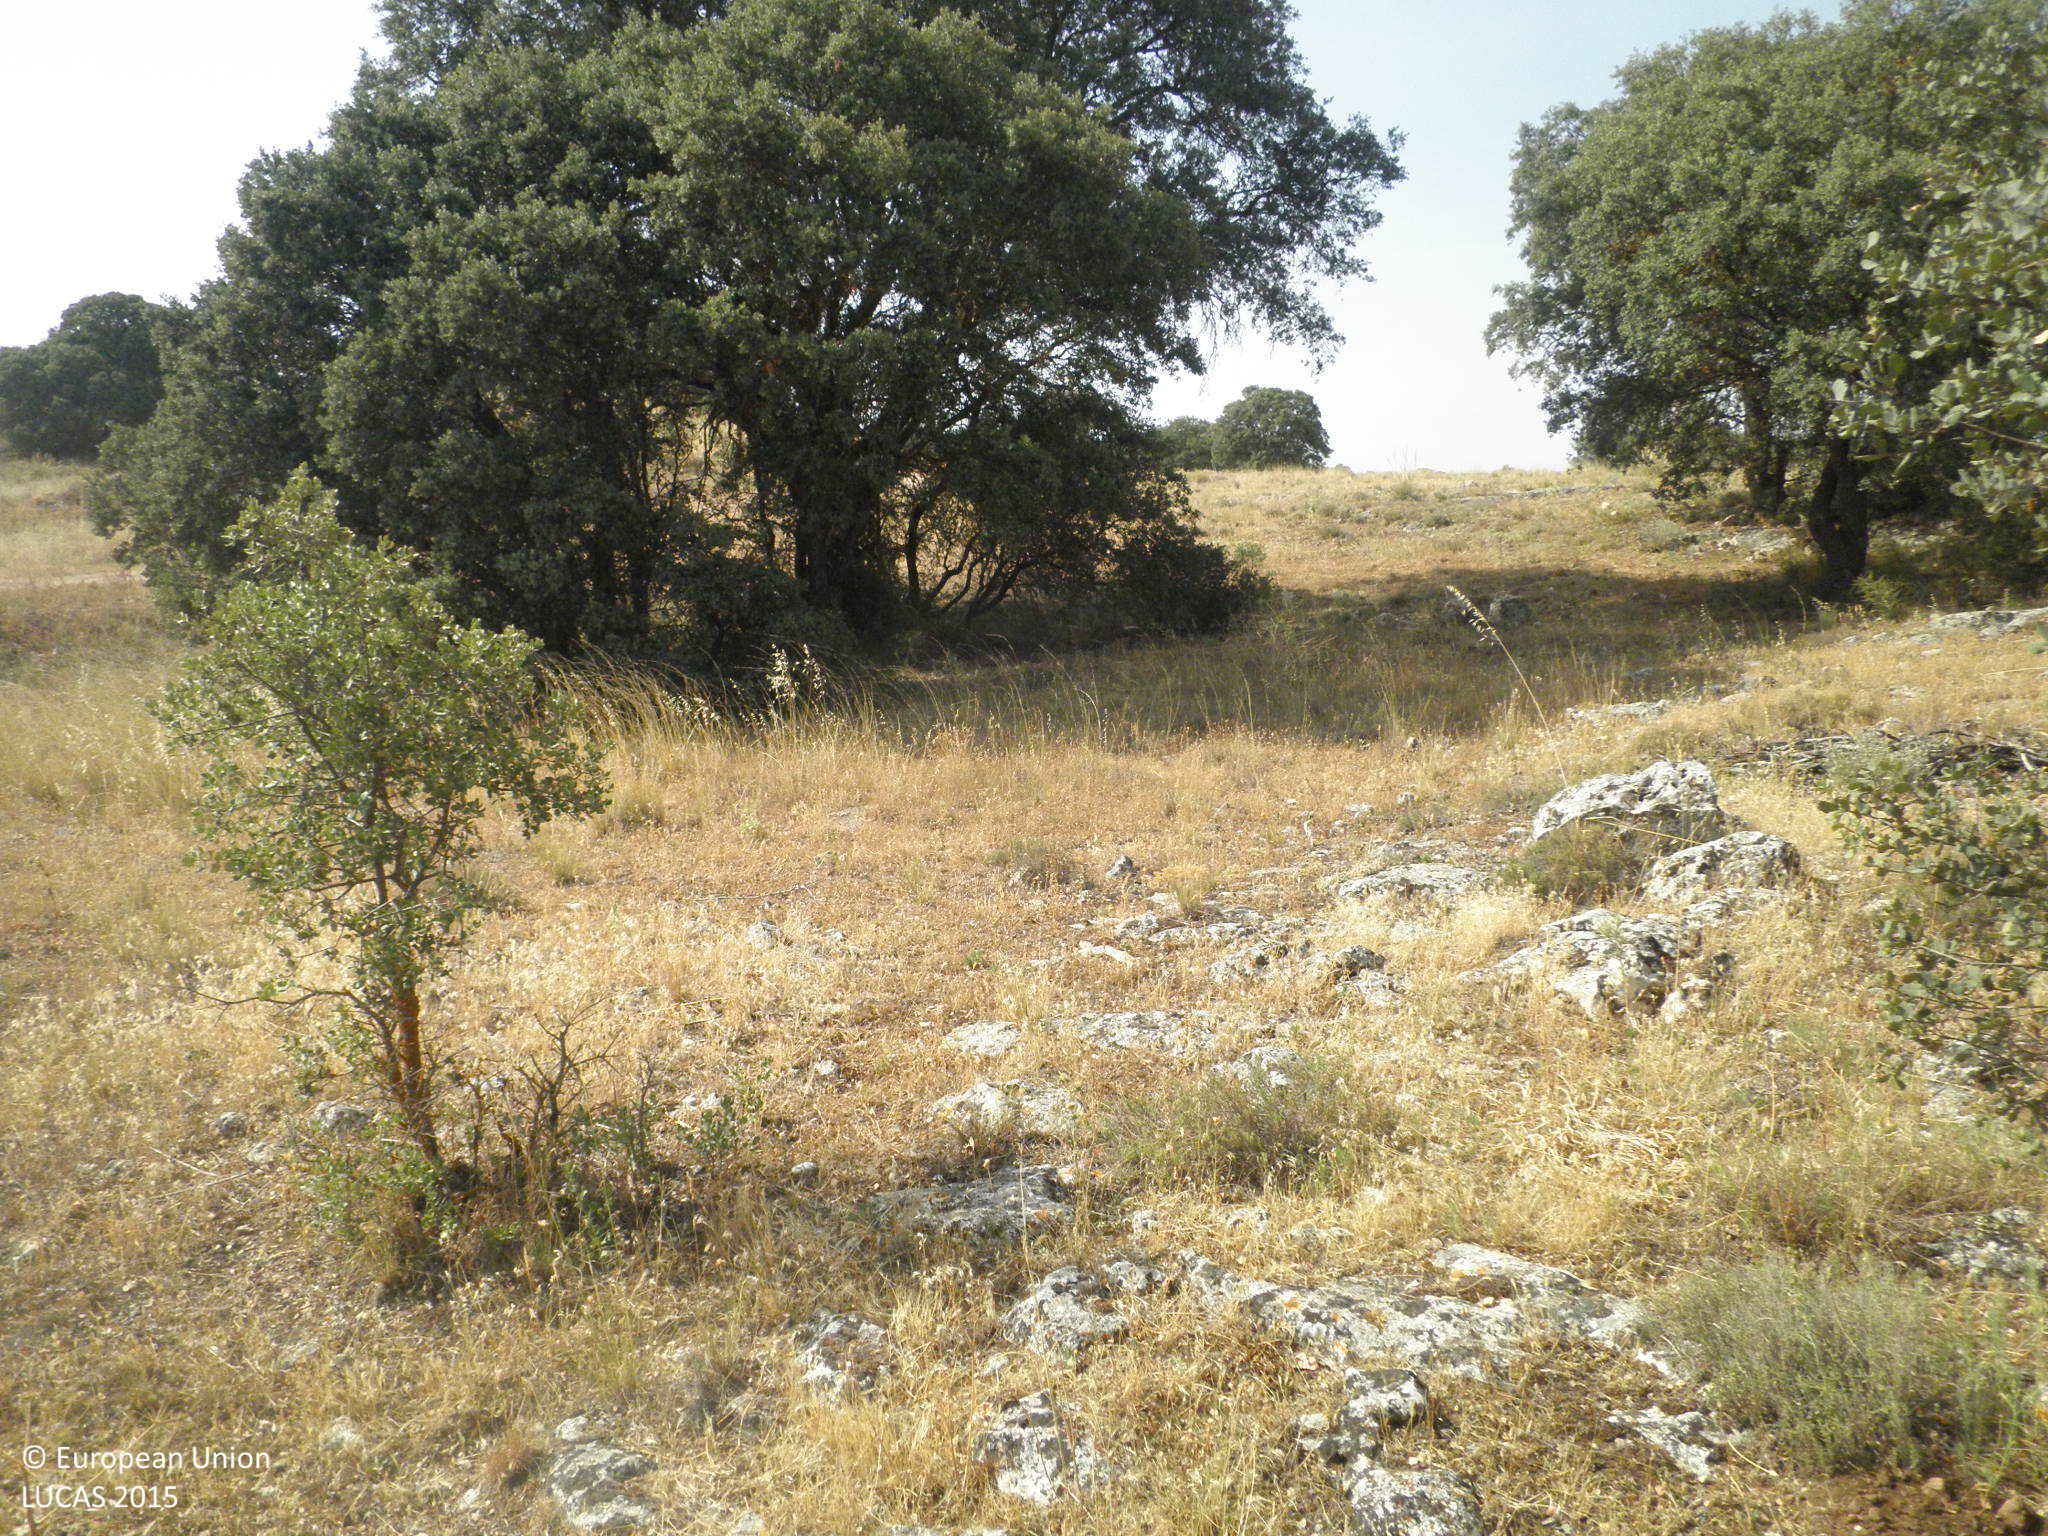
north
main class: Woodland
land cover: Broadleaved woodland
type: broadleaved evergreen forest
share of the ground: 25 - 50 %
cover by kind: herbaceous plants 55 %, broadleaved forest trees 30 %, consolidated bare surface 10 %, shrubs 5 %
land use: Semi-natural and natural areas not in use
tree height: > 5 m
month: July
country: ES
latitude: 39.5261
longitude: -2.5889
